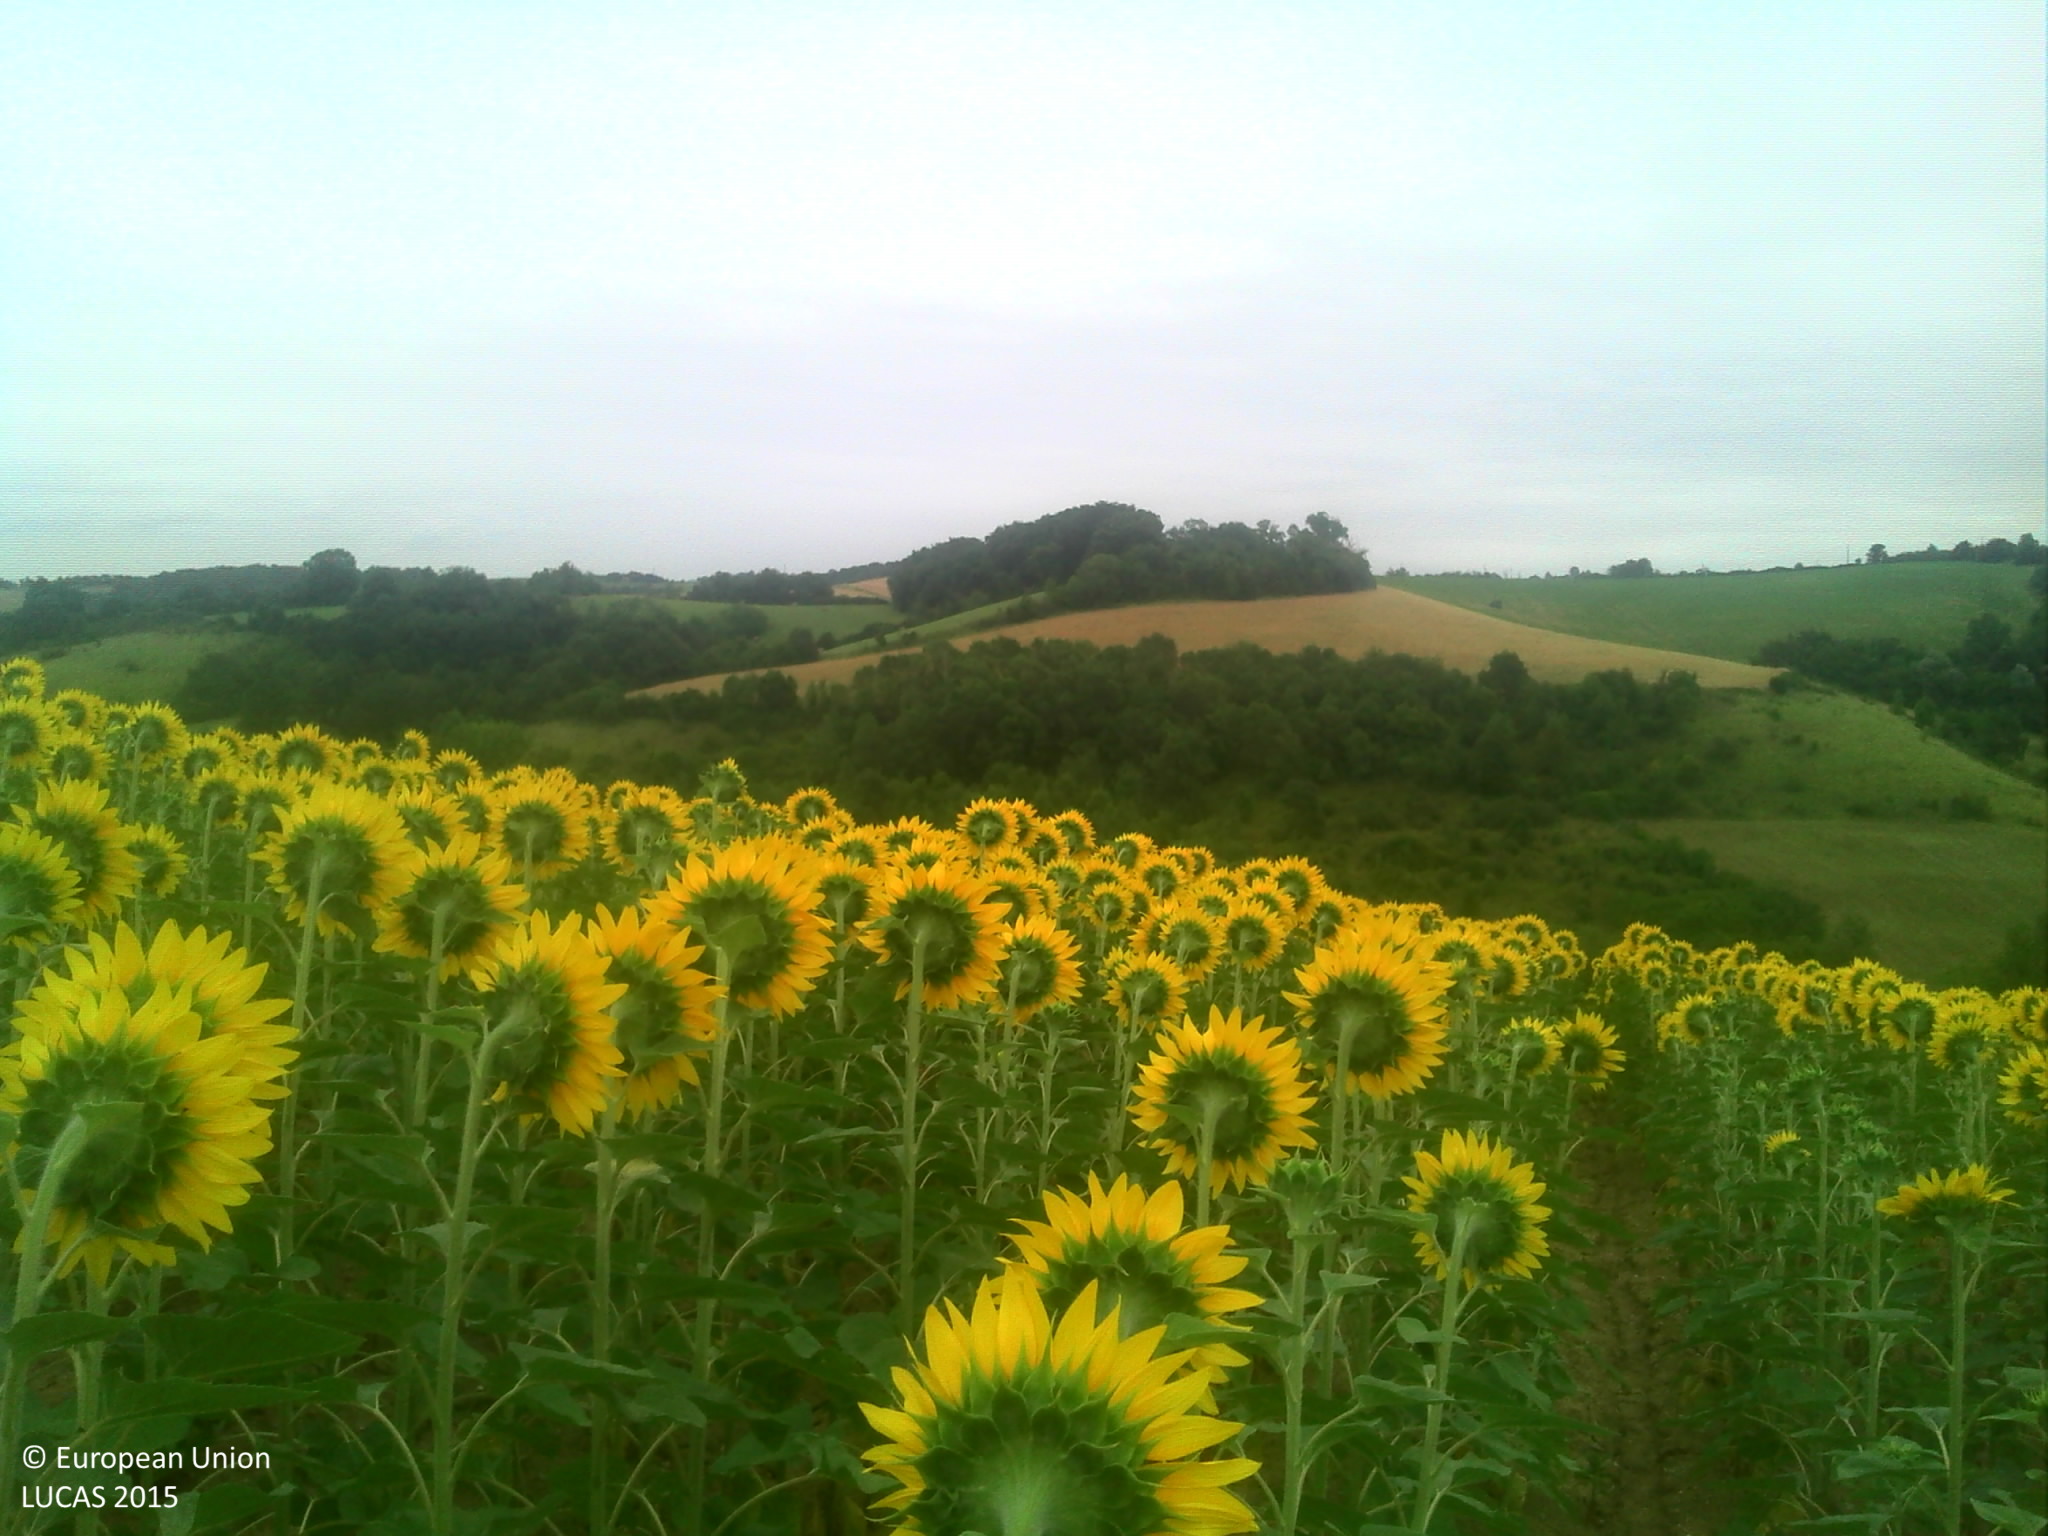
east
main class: Cropland
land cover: Sunflower
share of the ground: > 75 %
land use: Agriculture (excluding fallow land and kitchen gardens)
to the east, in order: Sunflower; Grass margins; Grassland without tree/shrub cover; Grass margins; Abandoned hedges; Rivers and streams; Broadleaved woodland; Grass margins; Grassland without tree/shrub cover
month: July
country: FR
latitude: 43.2194
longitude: 1.4736
